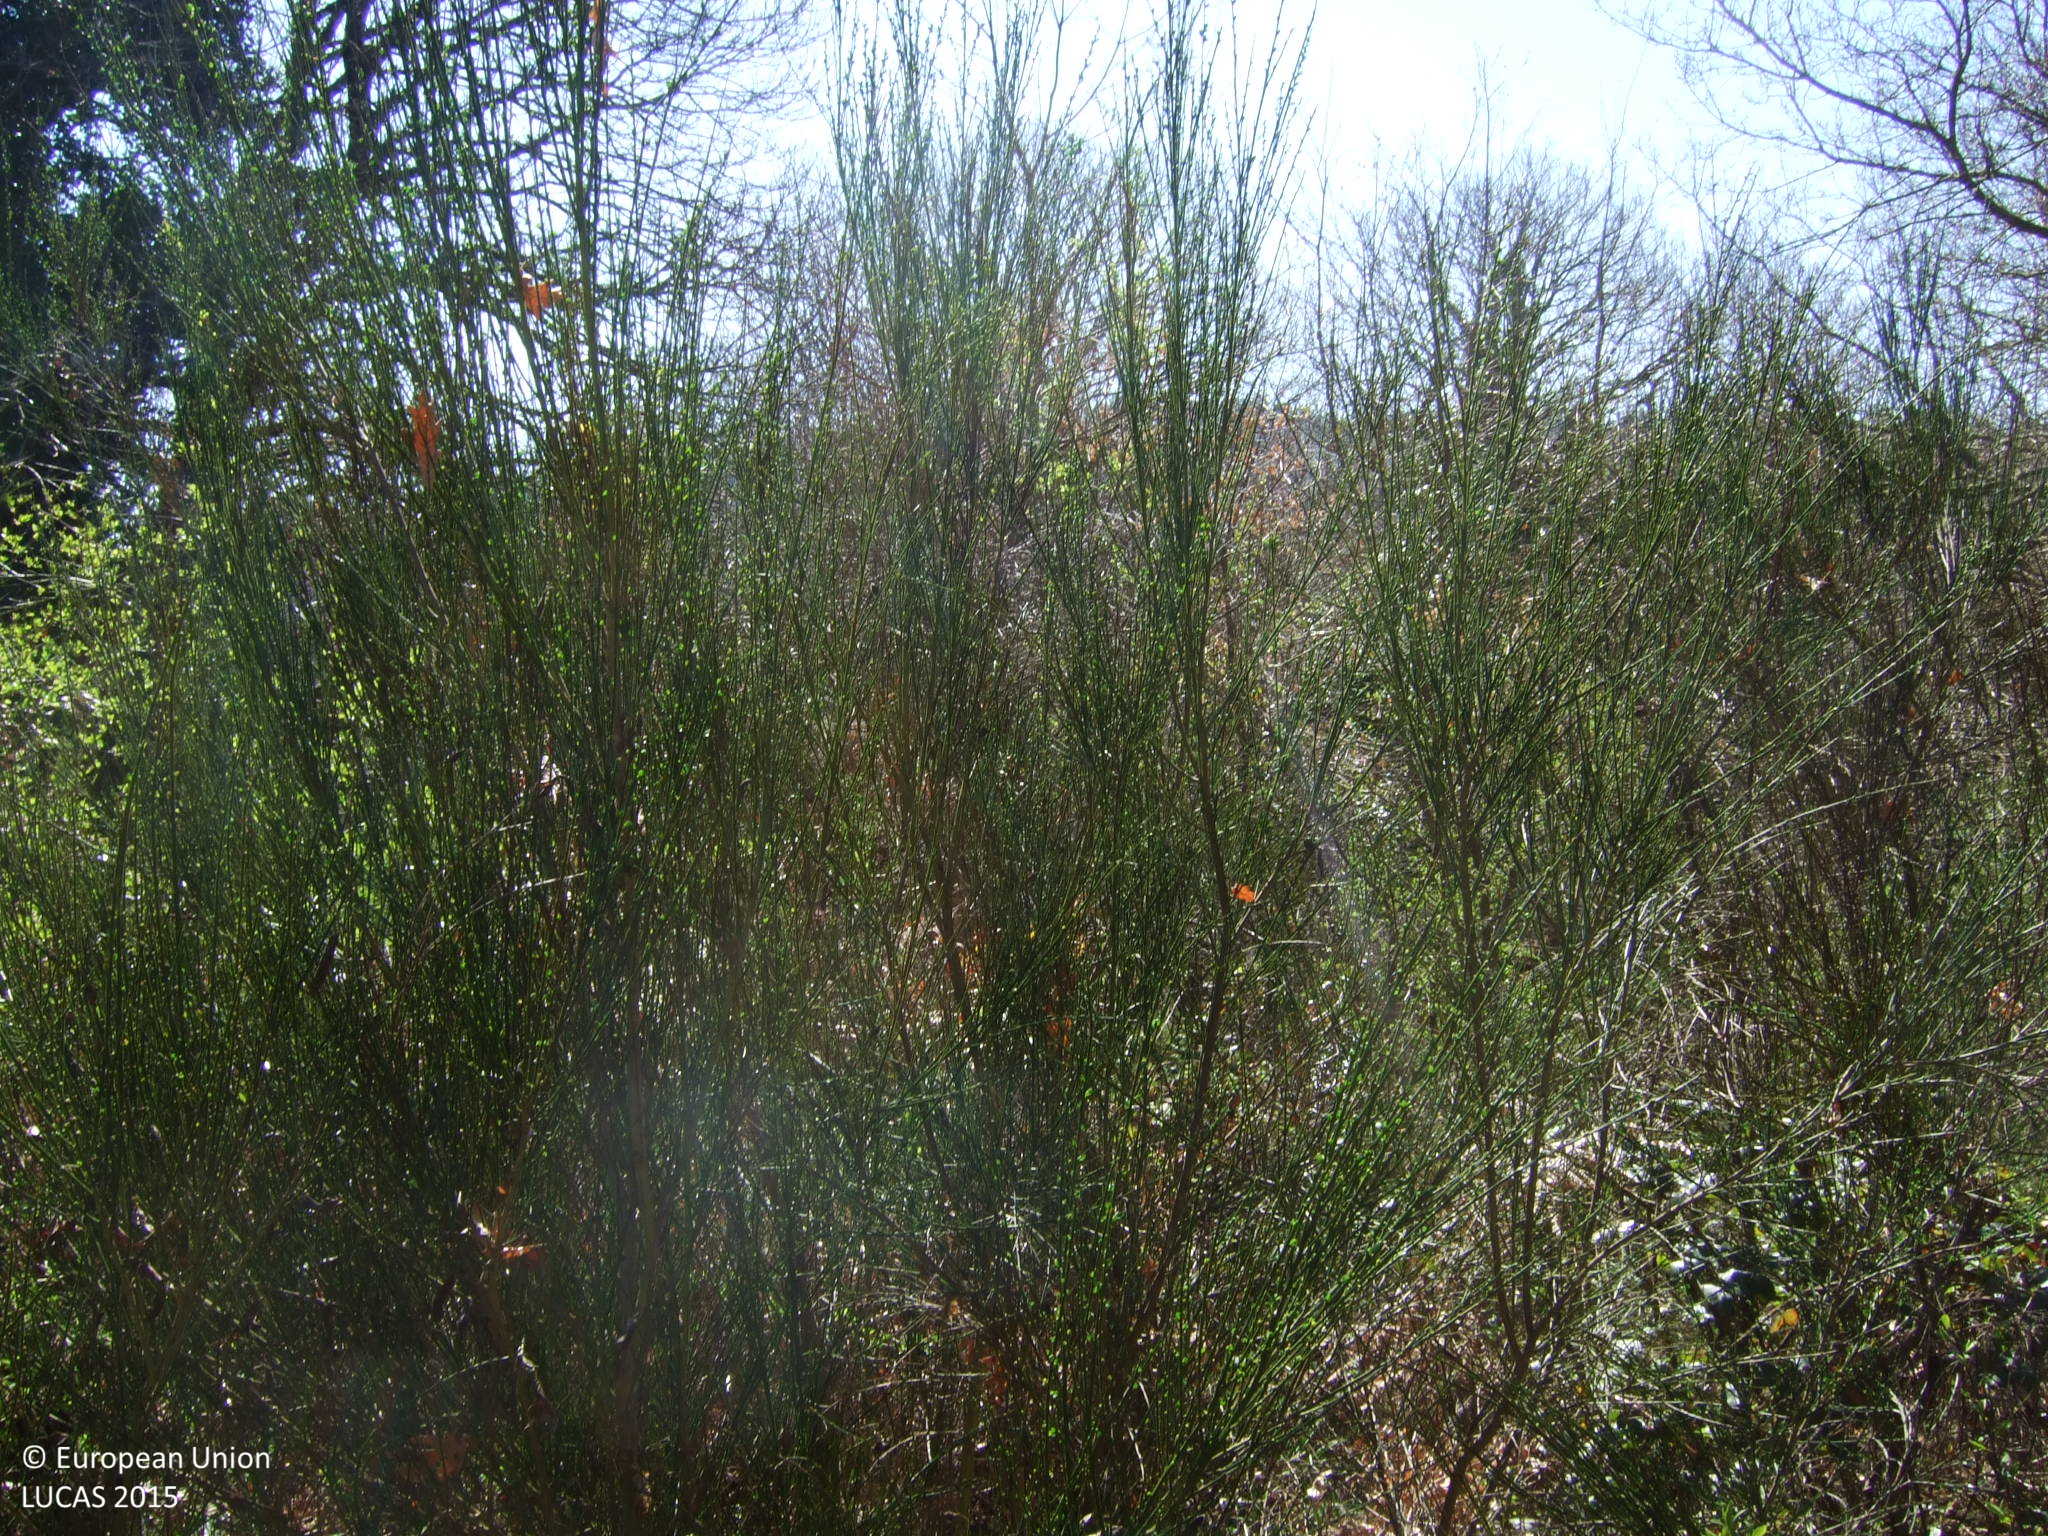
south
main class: Shrubland
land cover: Shrubland with sparse tree cover
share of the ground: > 75 %
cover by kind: shrubs 75 %, herbaceous plants 20 %, broadleaved forest trees 5 %
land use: Semi-natural and natural areas not in use
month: April
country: ES
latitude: 42.7050
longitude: -7.7946
